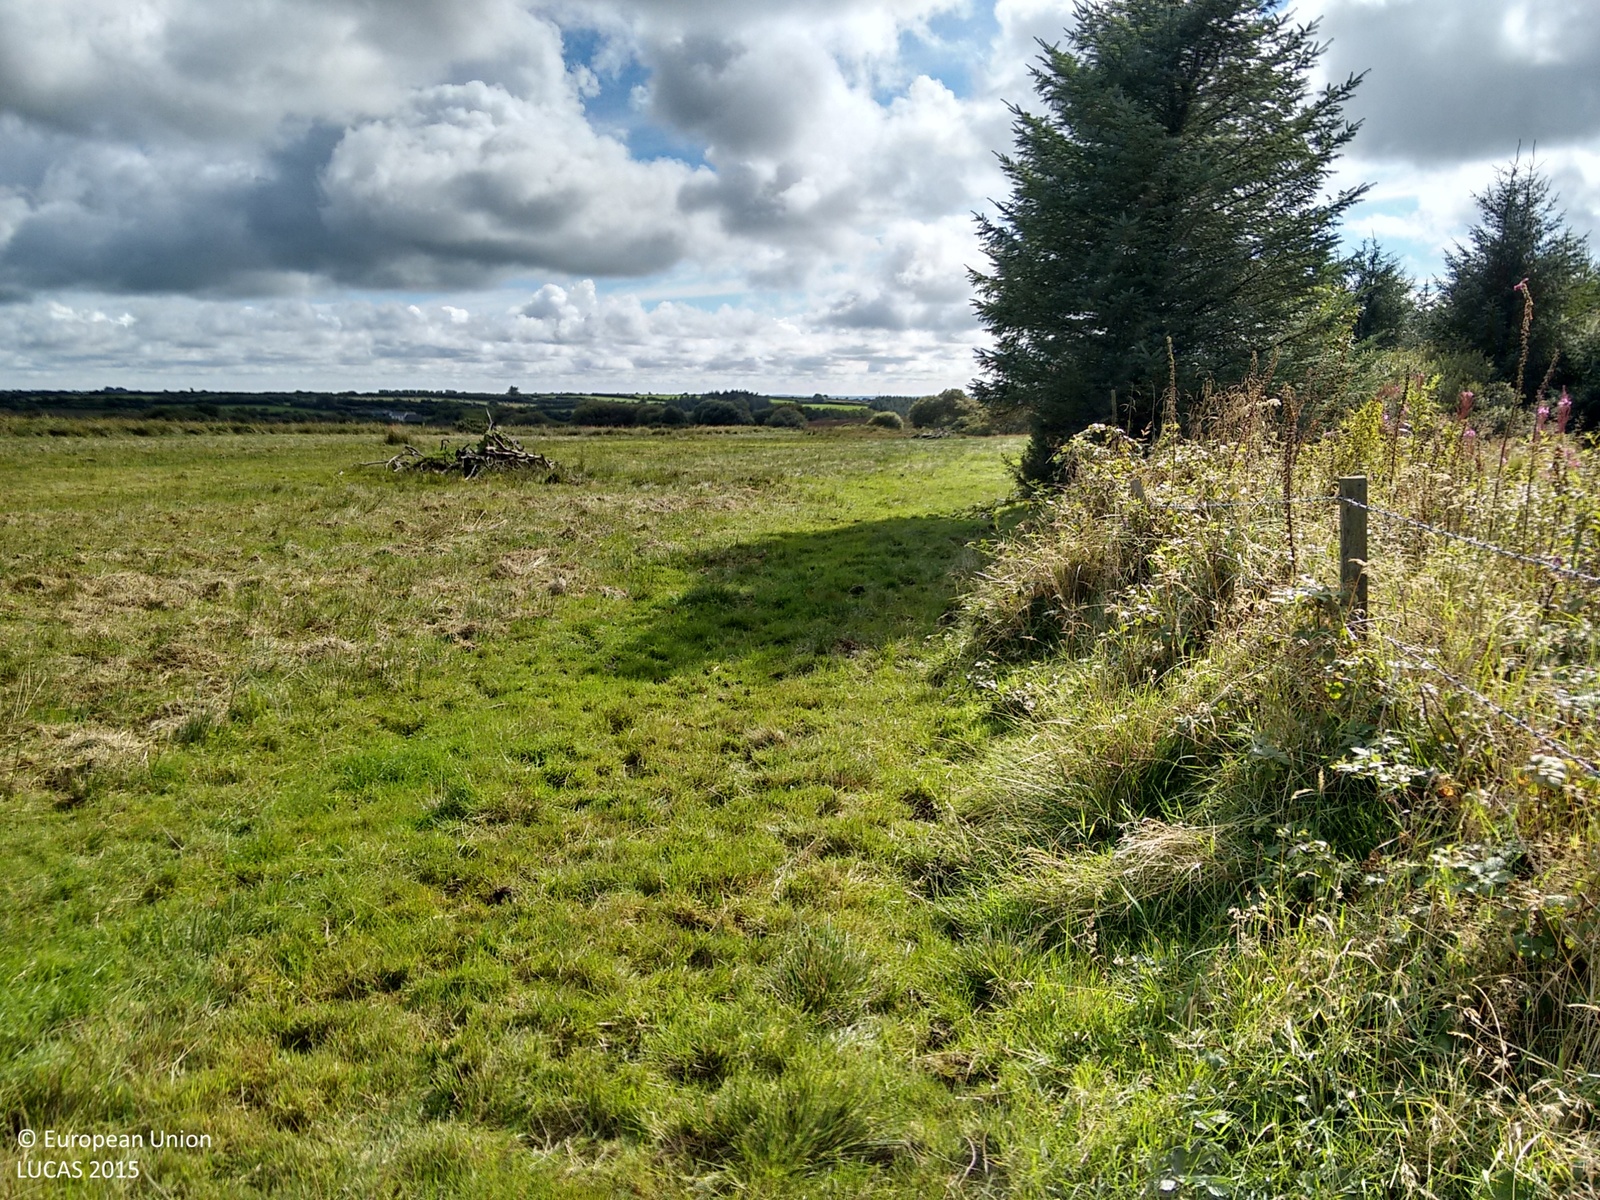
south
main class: Woodland
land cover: Spruce dominated coniferous woodland
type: exotic forest
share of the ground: > 75 %
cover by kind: coniferous forest trees 80 %, shrubs 20 %
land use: Forestry
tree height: > 5 m
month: August
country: GB
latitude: 51.9410
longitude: -4.9089
